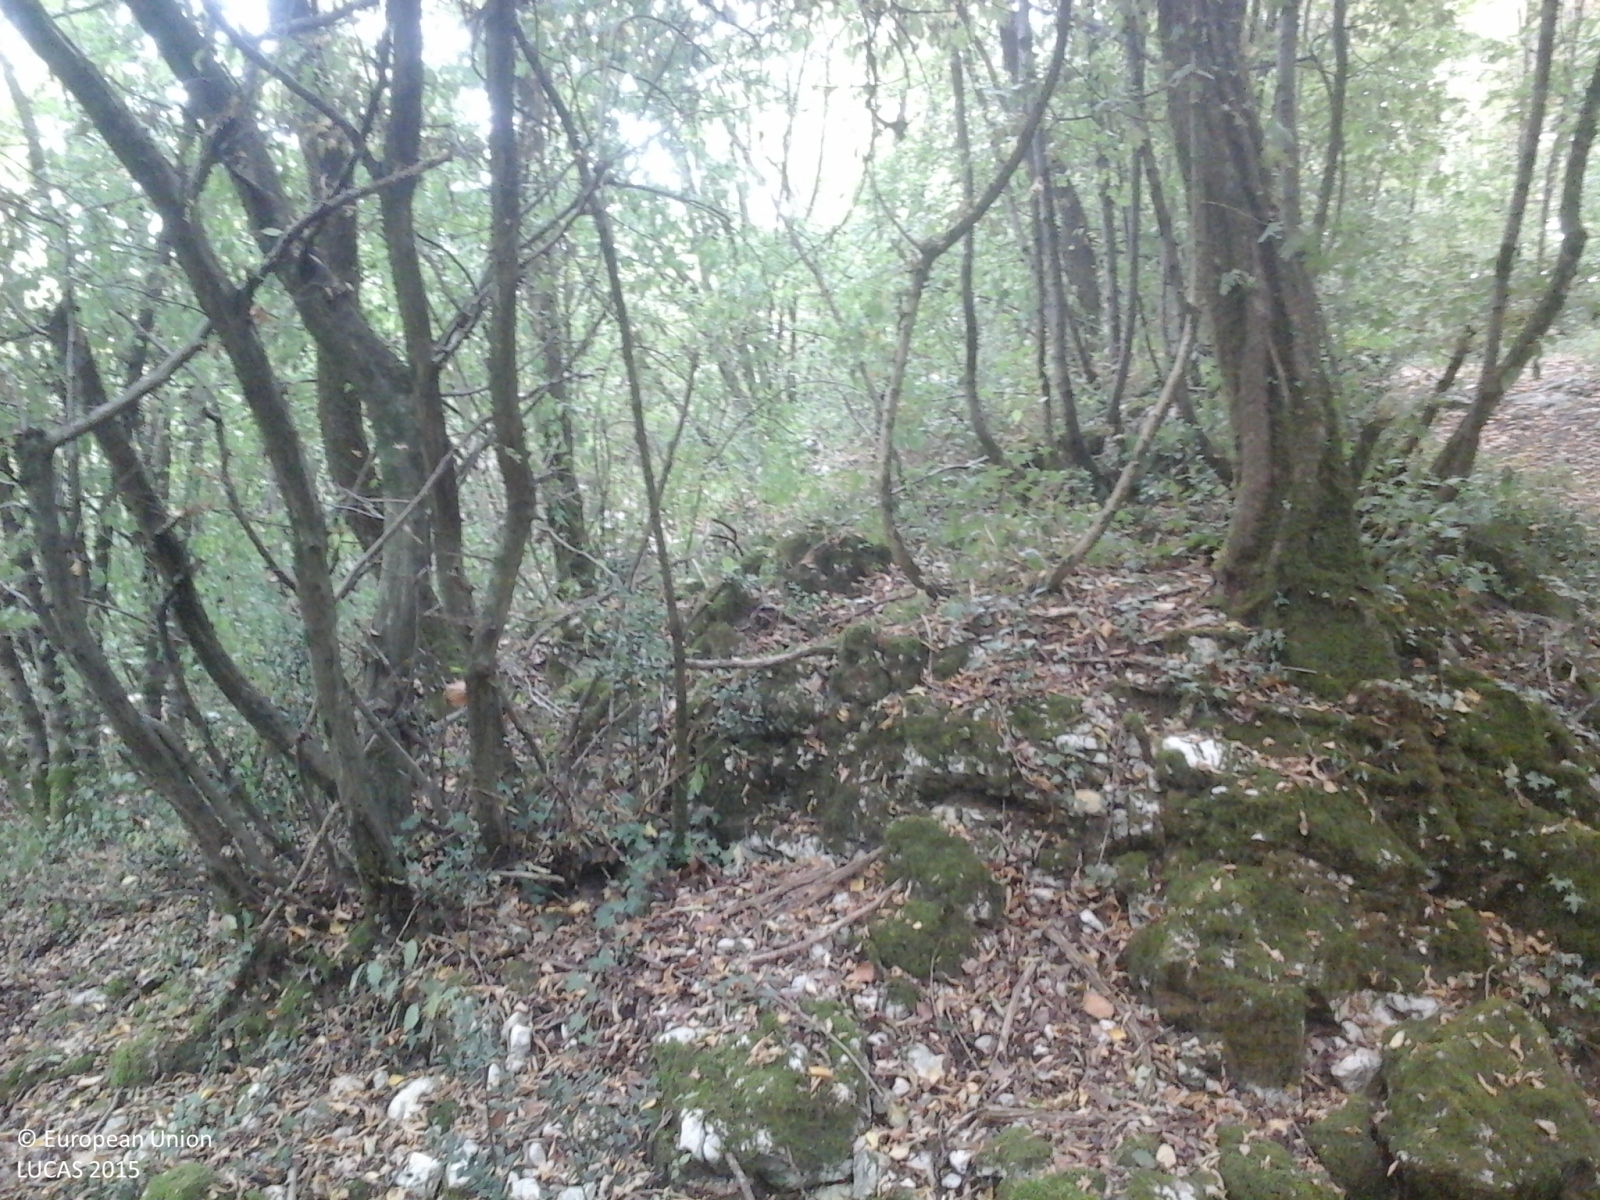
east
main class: Woodland
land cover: Broadleaved woodland
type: thermophilous deciduous forest
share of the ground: > 75 %
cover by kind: broadleaved forest trees 100 %
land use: Semi-natural and natural areas not in use
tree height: > 5 m
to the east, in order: Broadleaved woodland; Grassland without tree/shrub cover; Ditches and canals; Grassland without tree/shrub cover
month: July
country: IT
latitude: 45.5756
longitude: 10.4222
